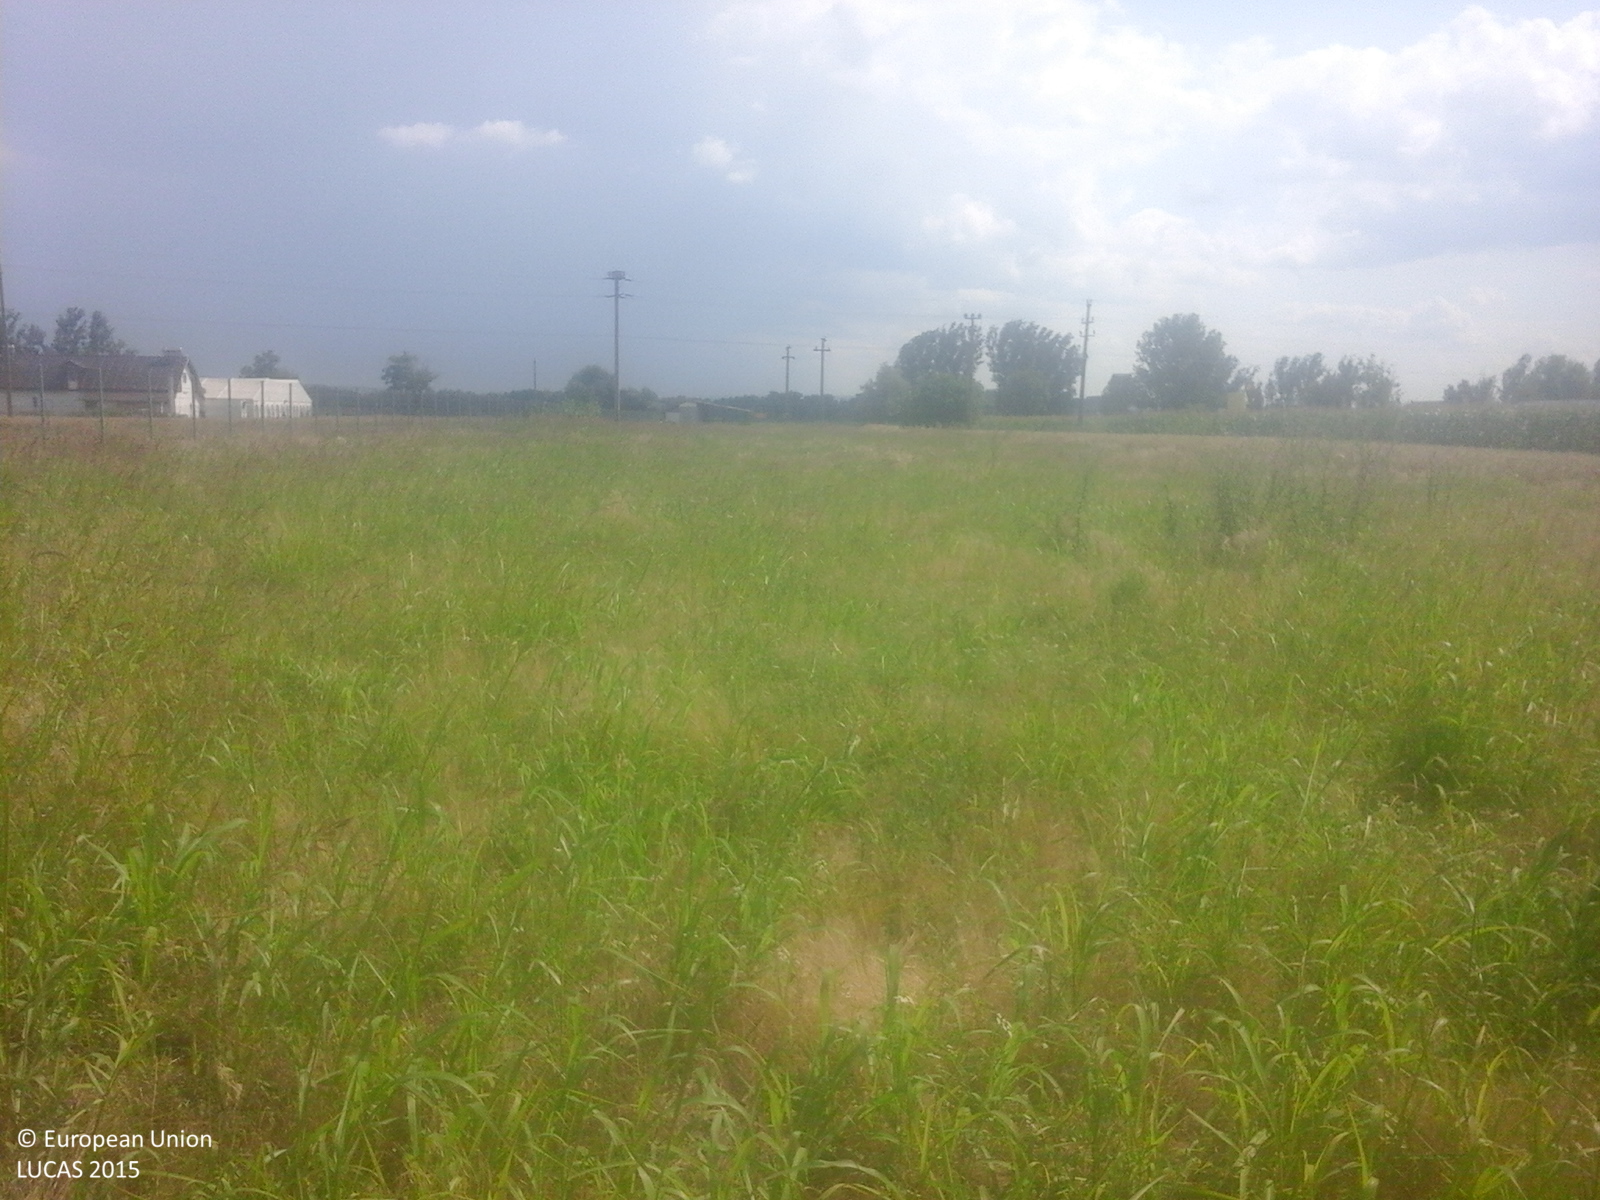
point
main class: Grassland
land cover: Grassland without tree/shrub cover
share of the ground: > 75 %
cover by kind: herbaceous plants 100 %
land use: Agriculture (excluding fallow land and kitchen gardens)
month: July
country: RO
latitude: 43.7777
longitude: 24.5397
